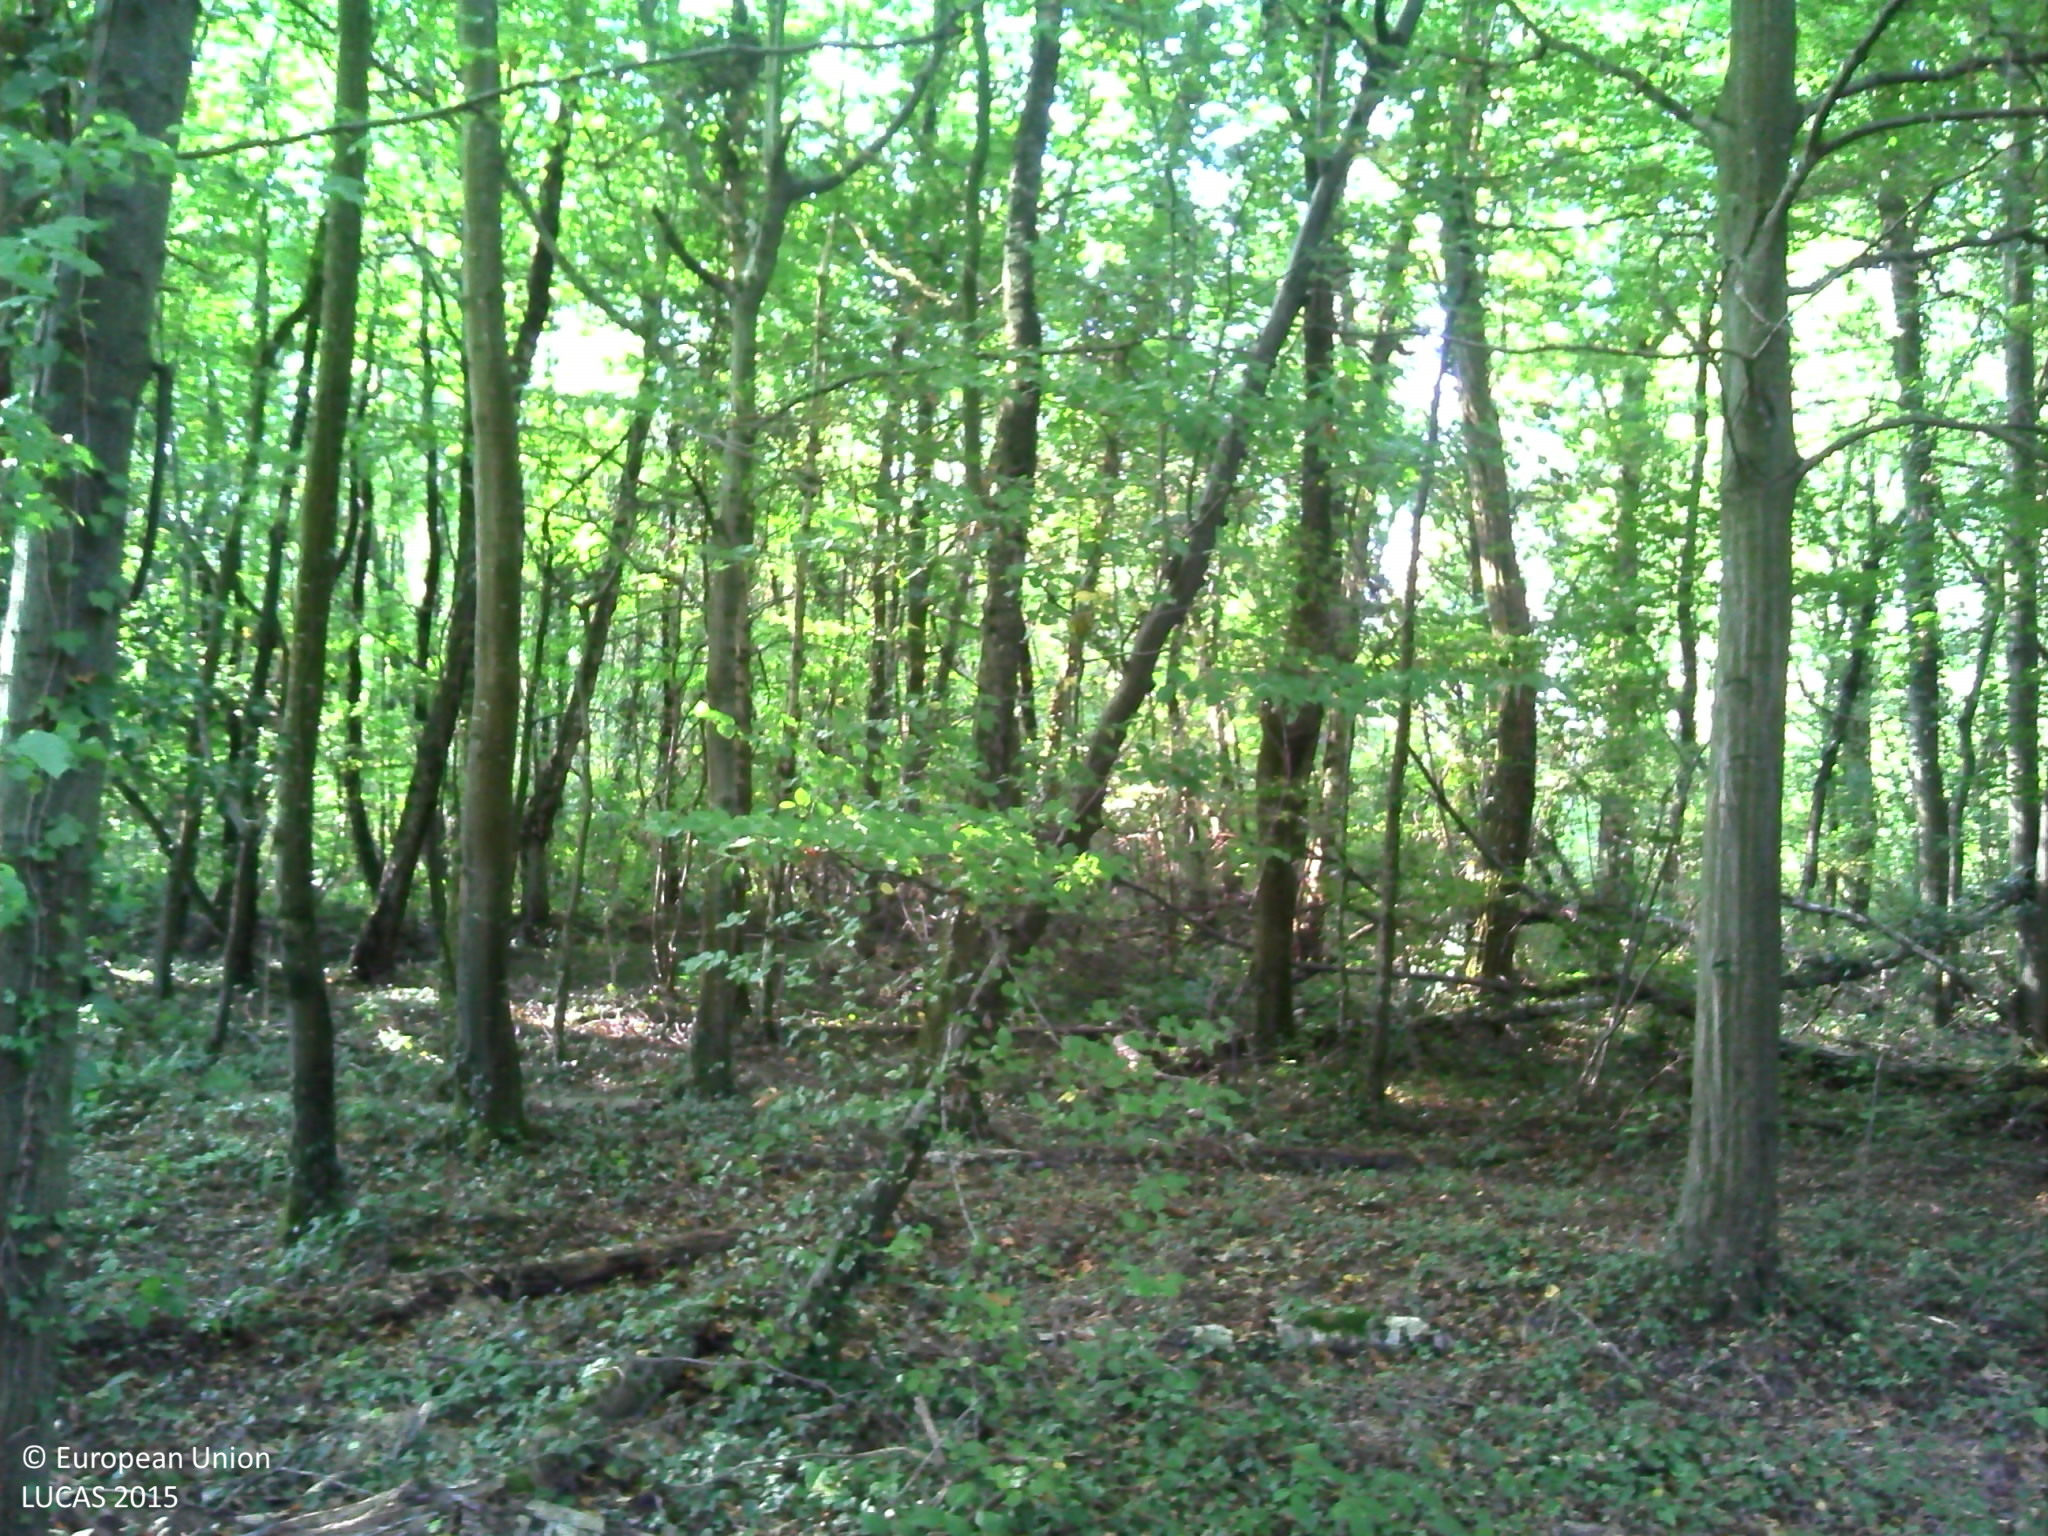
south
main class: Woodland
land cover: Broadleaved woodland
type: mesophytic deciduous forest
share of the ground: > 75 %
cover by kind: broadleaved forest trees 90 %, shrubs 5 %, herbaceous plants 5 %
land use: Forestry
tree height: > 5 m
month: October
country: FR
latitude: 45.9269
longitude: 4.9870
